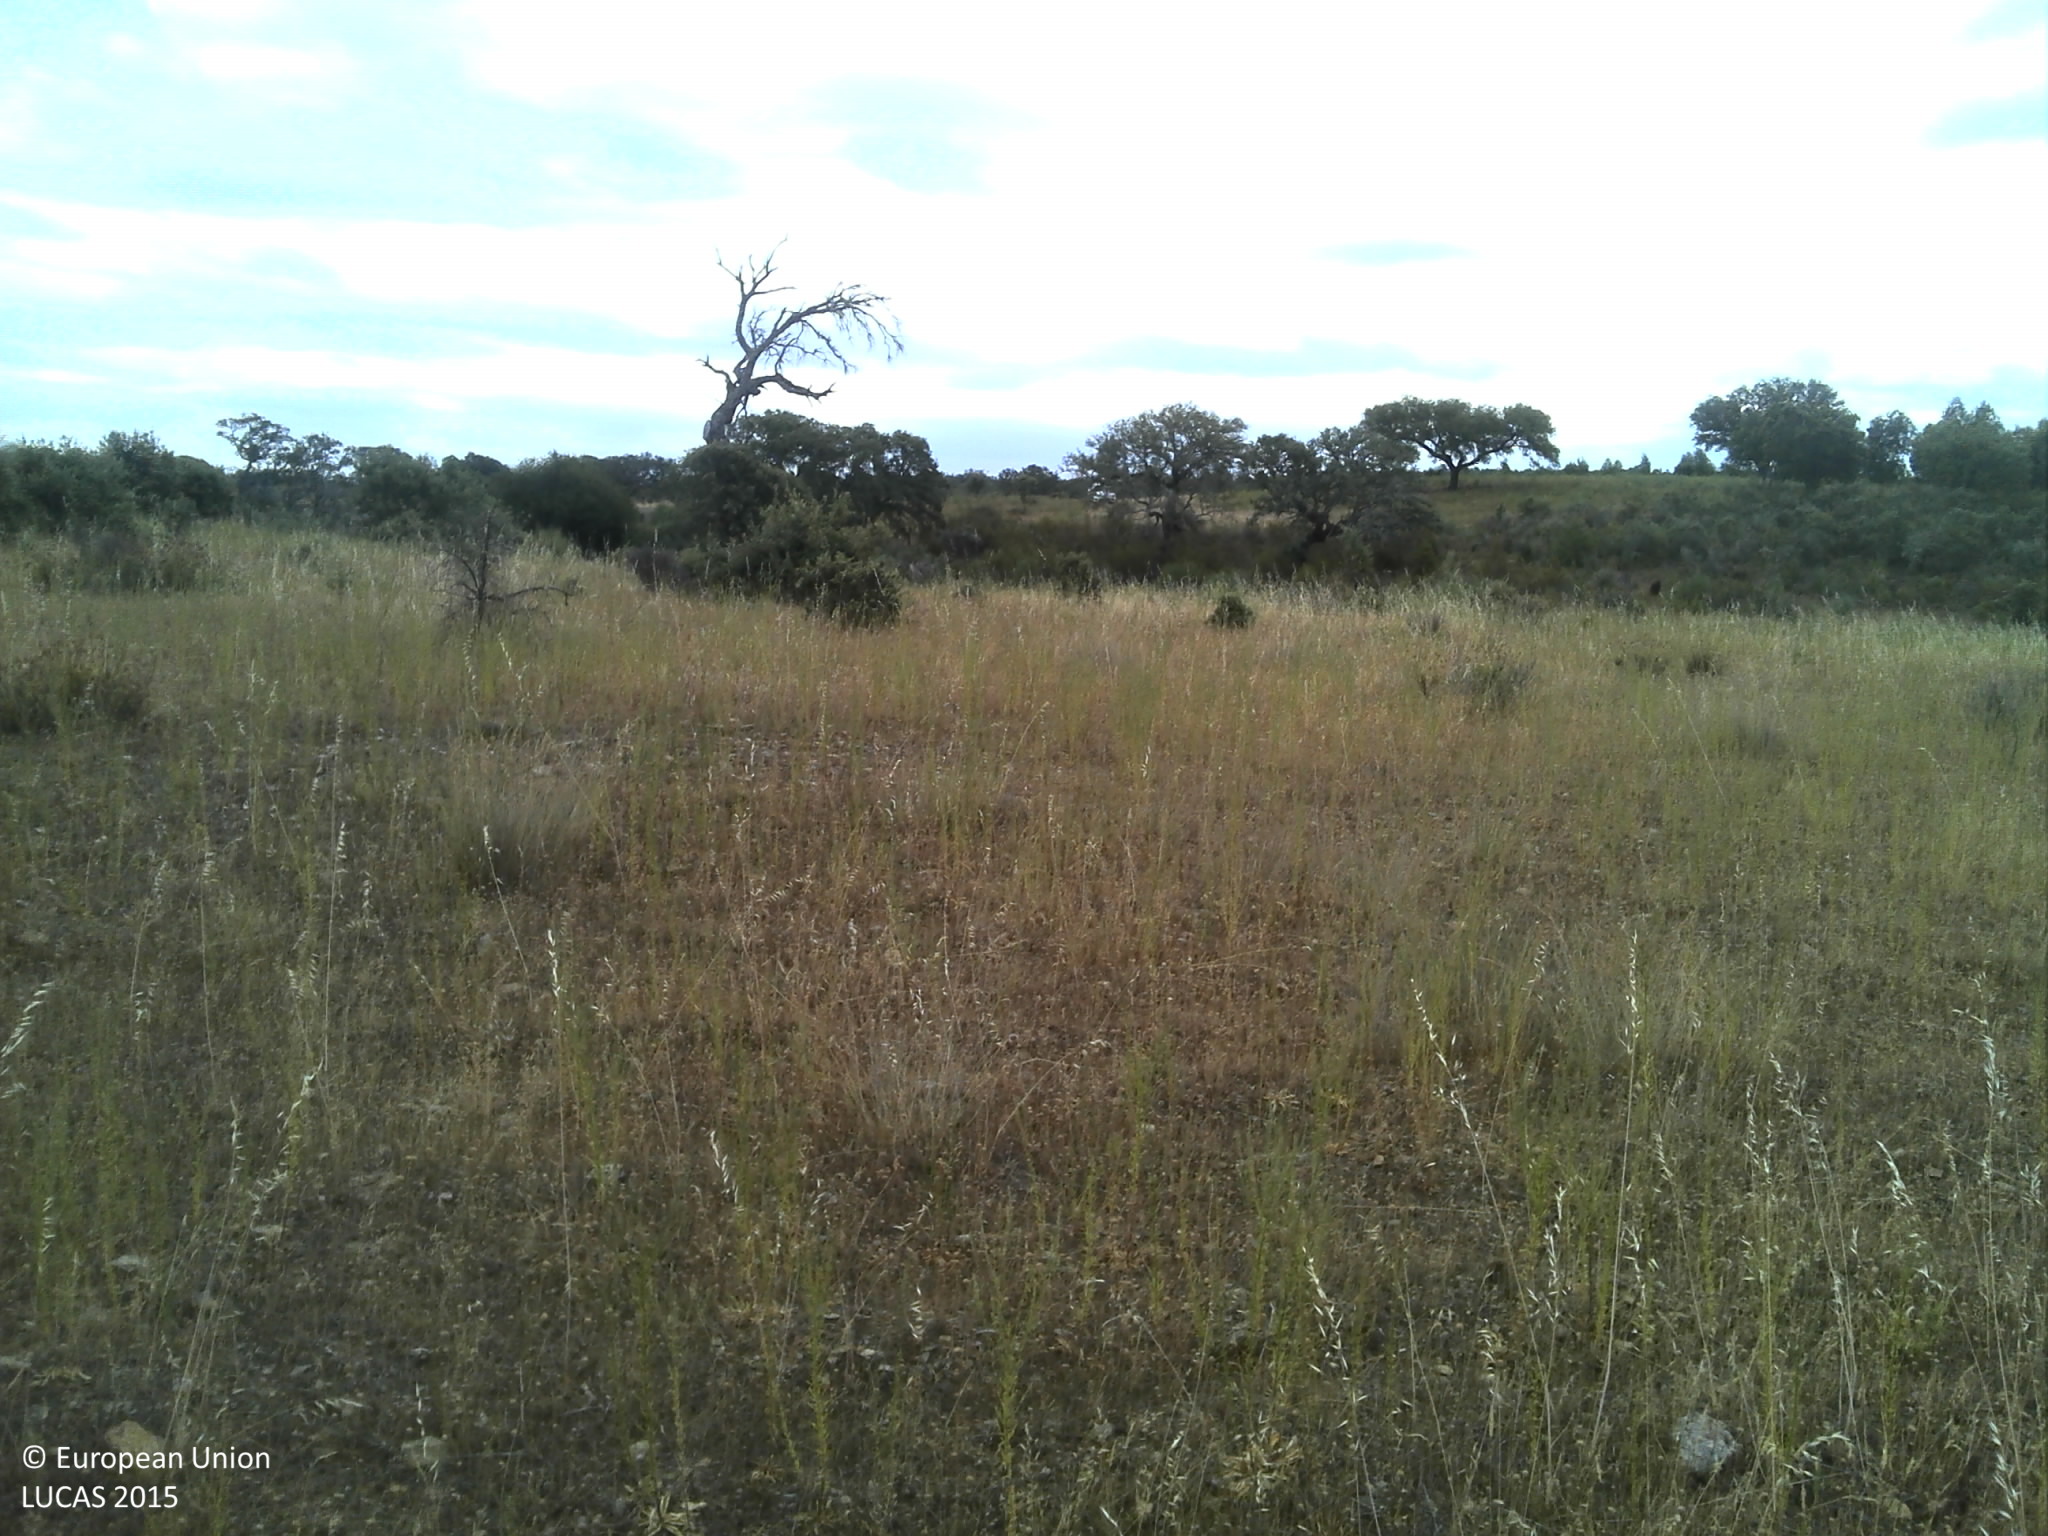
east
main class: Grassland
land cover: Grassland without tree/shrub cover
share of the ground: 50 - 75 %
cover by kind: herbaceous plants 60 %, unconsolidated bare surface 35 %, shrubs 5 %
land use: Agriculture (excluding fallow land and kitchen gardens)
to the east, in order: Grassland without tree/shrub cover; Rivers and streams; Shrubland with sparse tree cover; Fences; Grassland with sparse tree/shrub cover
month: June
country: PT
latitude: 40.1430
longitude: -7.2717
